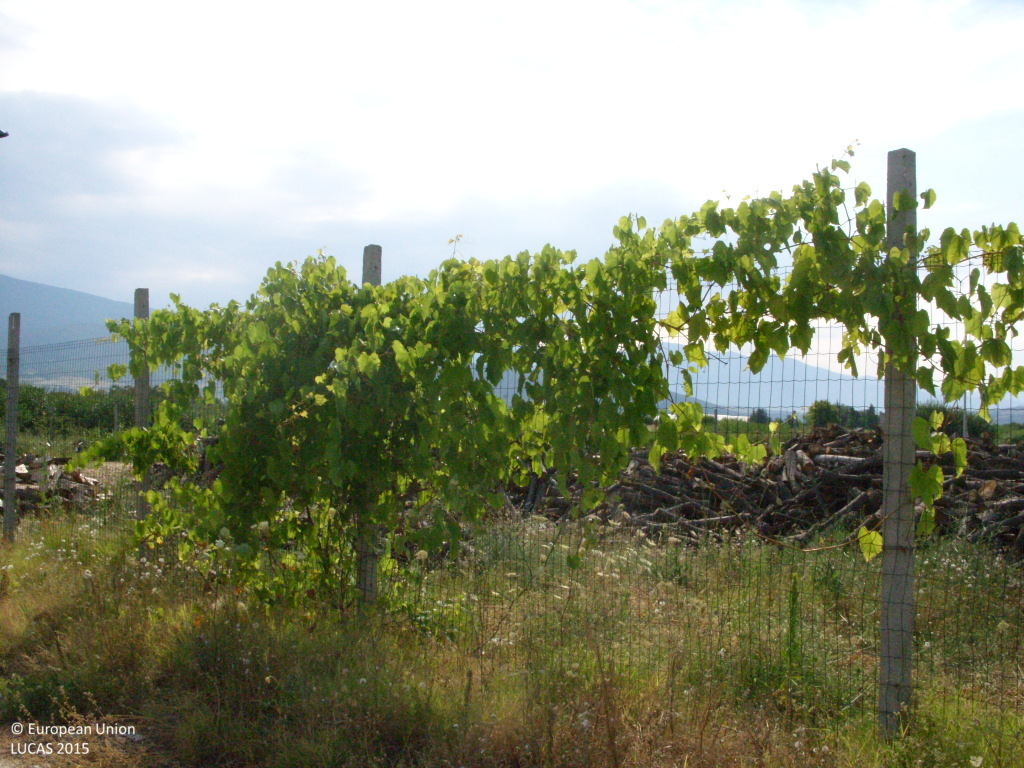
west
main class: Grassland
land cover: Grassland with sparse tree/shrub cover
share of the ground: > 75 %
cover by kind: herbaceous plants 90 %, broadleaved forest trees 5 %, shrubs 5 %
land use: Abandoned areas
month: July
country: BG
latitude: 42.2073
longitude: 24.1280
